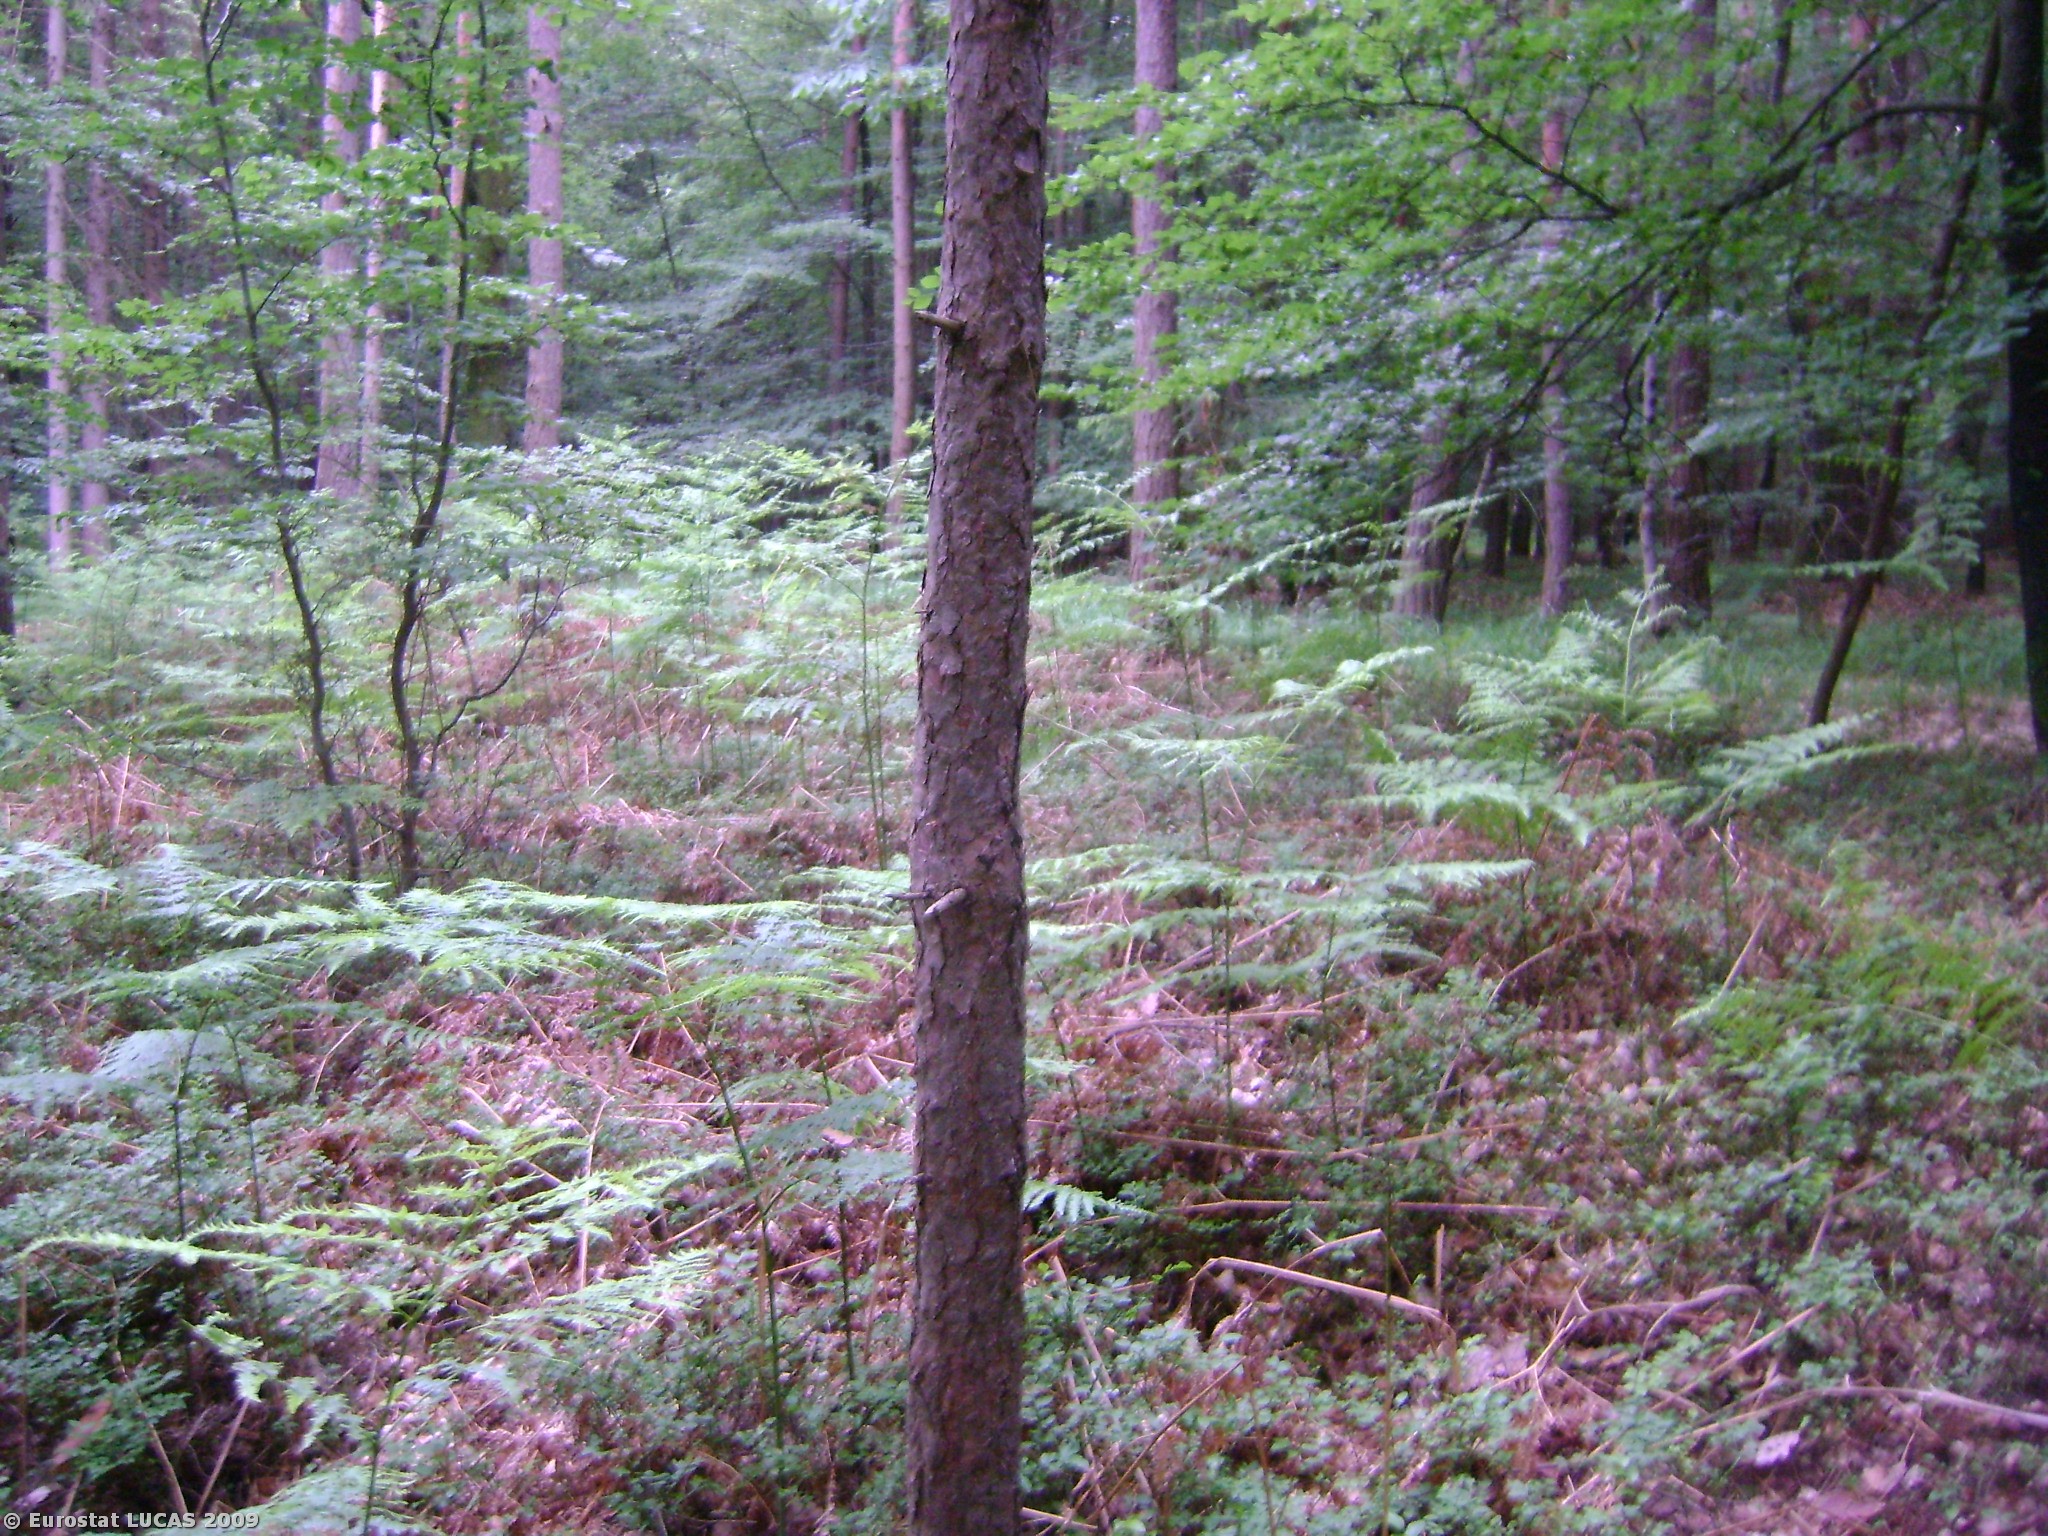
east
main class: Woodland
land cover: Broadleaved woodland
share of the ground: > 75 %
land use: Forestry
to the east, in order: Broadleaved woodland; Mixed woodland; Shrubland with sparse tree cover; Mixed woodland; Broadleaved woodland; Tracks; Broadleaved woodland; Tracks; Broadleaved woodland
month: June
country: AT
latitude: 46.8668
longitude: 15.7066
